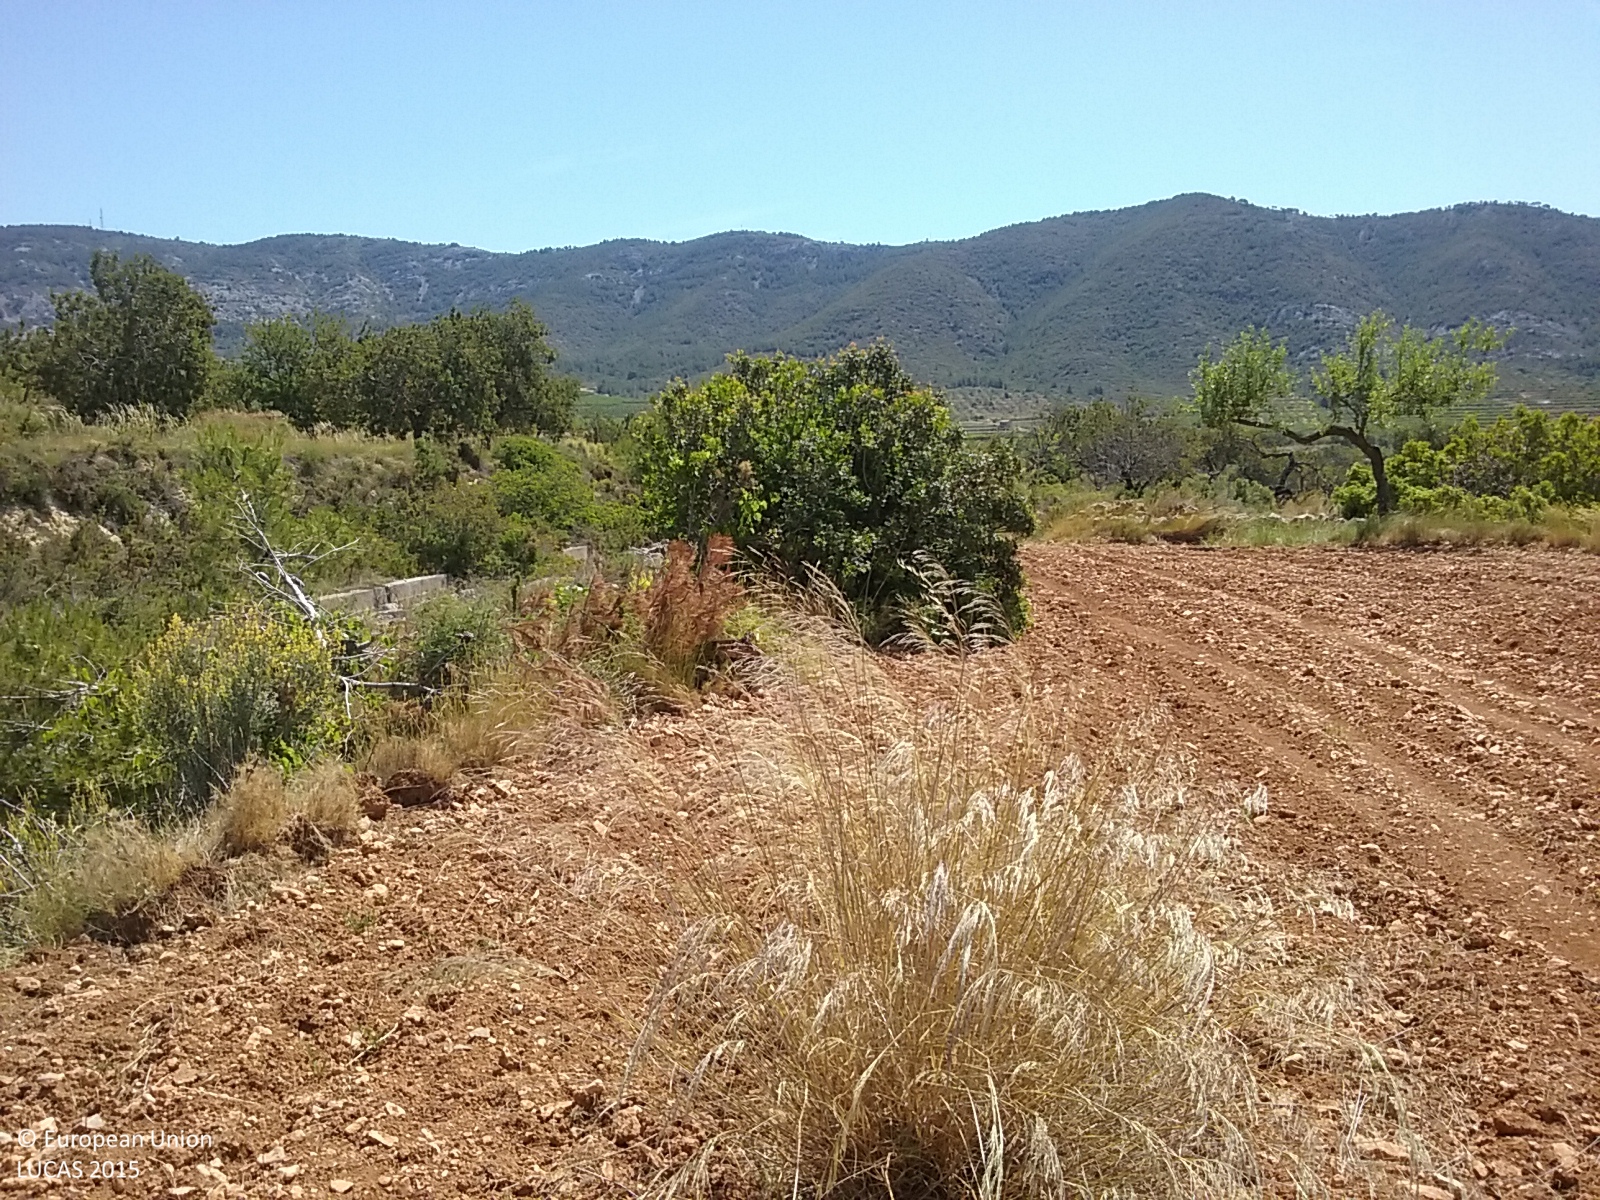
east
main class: Cropland
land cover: Nuts trees
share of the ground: < 10 %
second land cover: Other bare soil
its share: > 75 %
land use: Agriculture (excluding fallow land and kitchen gardens)
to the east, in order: Nuts trees; Other bare soil; Shrubland with sparse tree cover; Artificial constructions; Ditches and canals; Other structural elements; Ditches and canals; Artificial constructions; Shrubland with sparse tree cover; Permanent industrial crops; Tracks; Shruby margins; Dry stone walls; Tracks; Shrubland with sparse tree cover; Dry stone walls; Other citrus fruit; Dry stone walls; Other citrus fruit
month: May
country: ES
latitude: 40.2721
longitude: 0.2484
